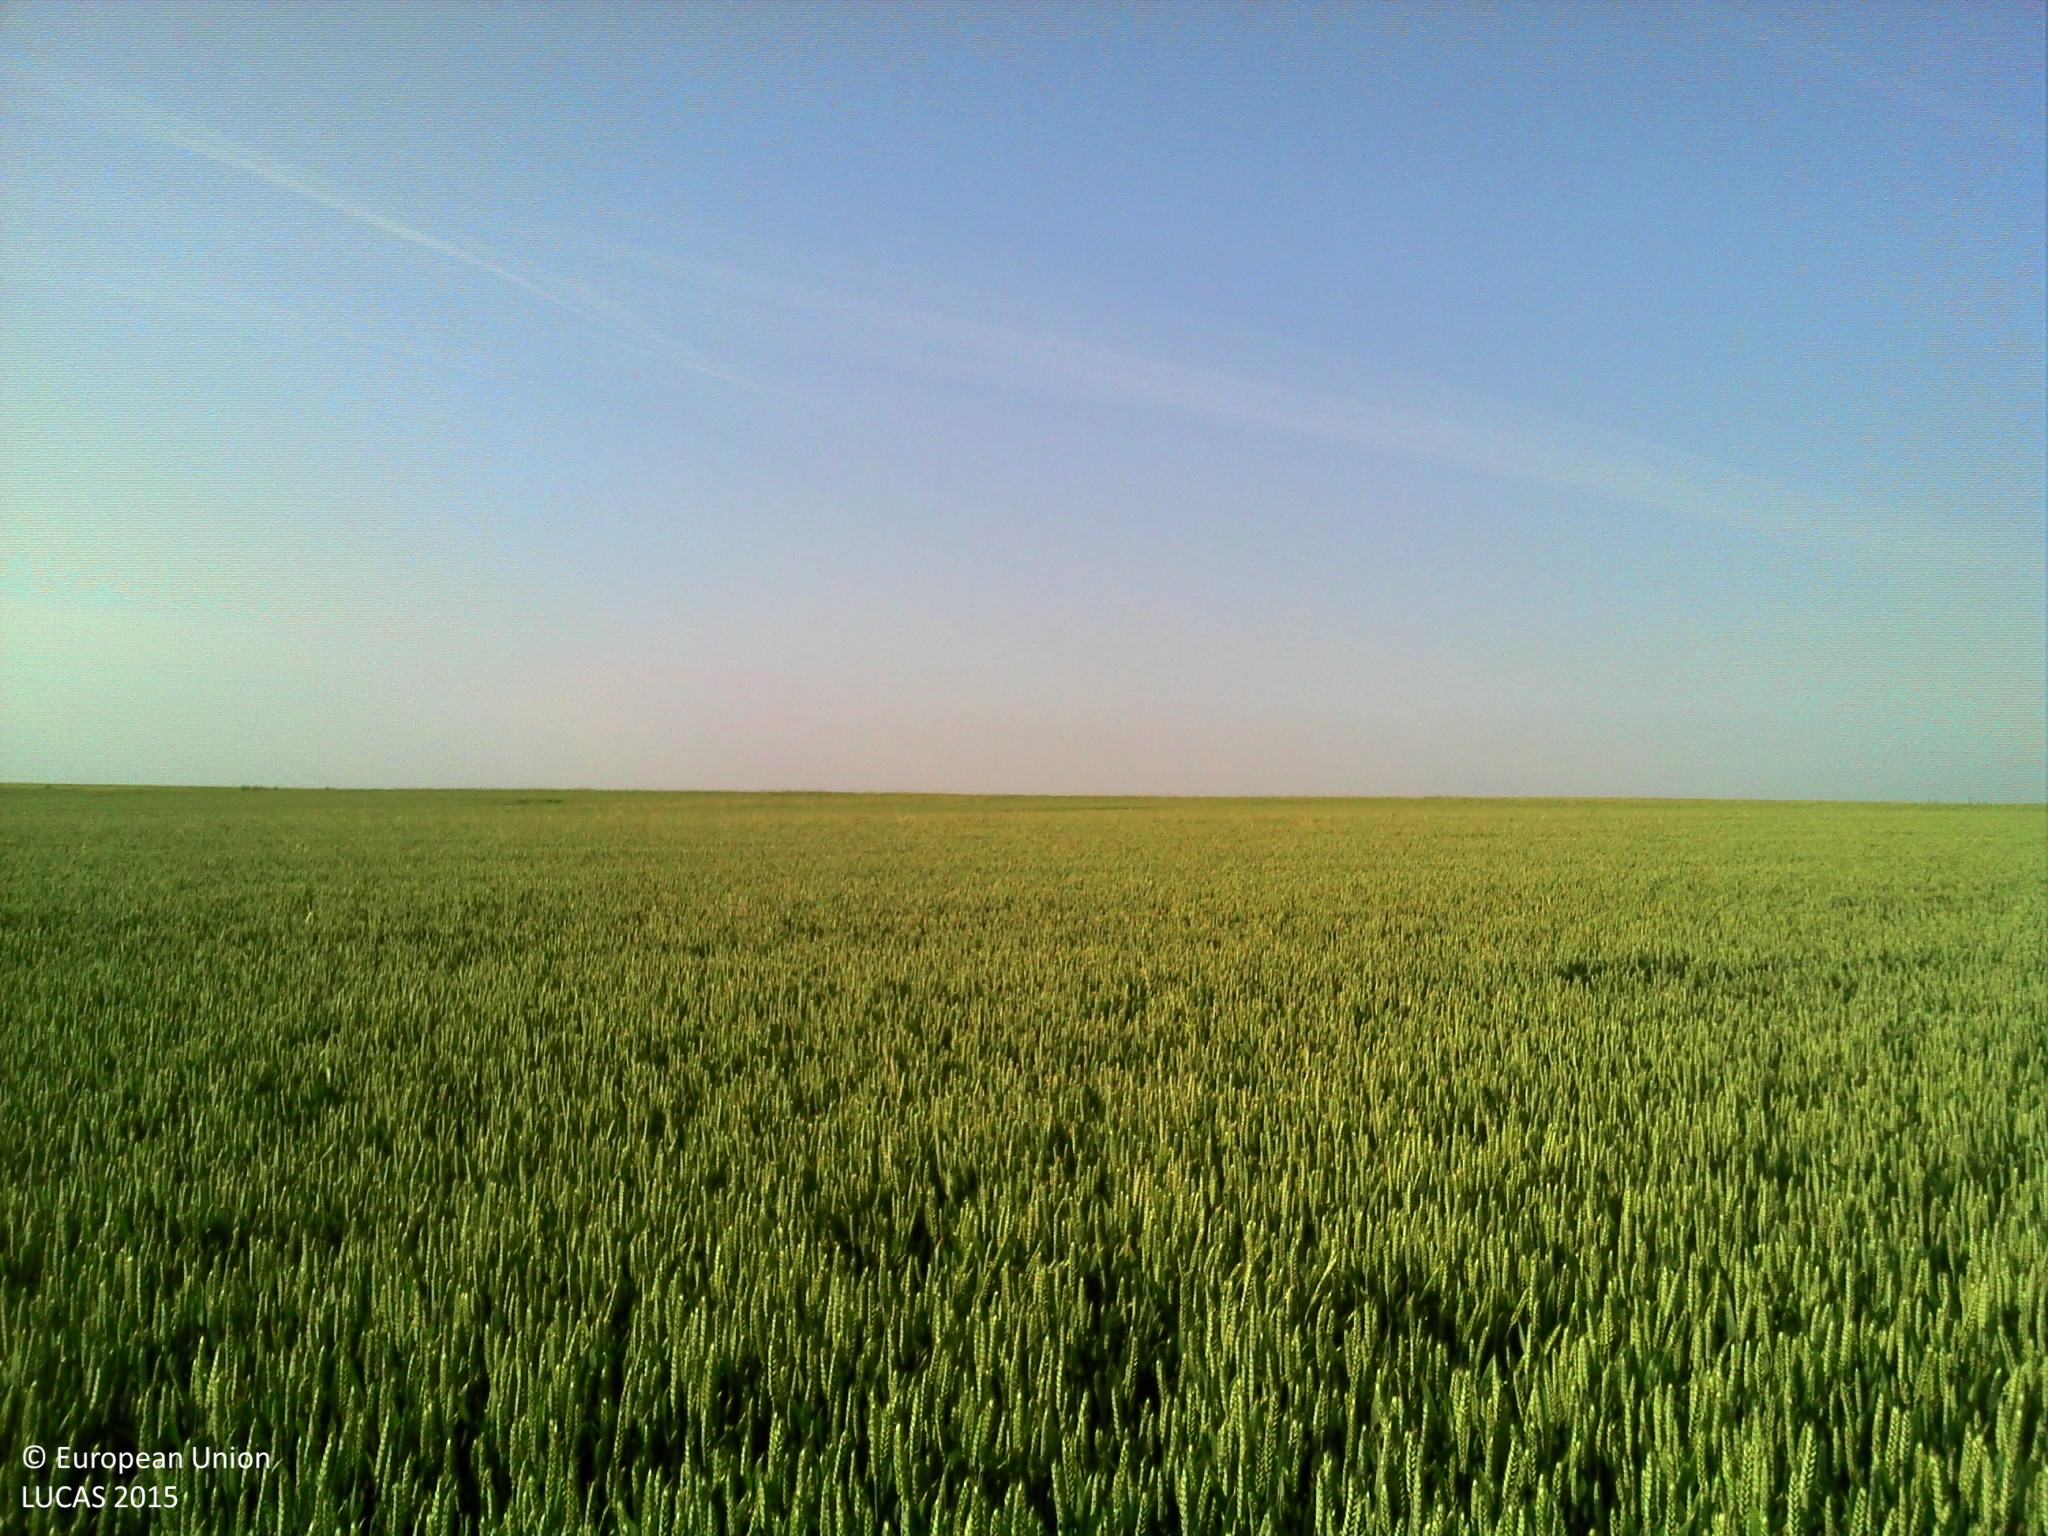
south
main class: Cropland
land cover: Common wheat
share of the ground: > 75 %
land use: Agriculture (excluding fallow land and kitchen gardens)
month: June
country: FR
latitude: 49.4350
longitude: 2.5557
